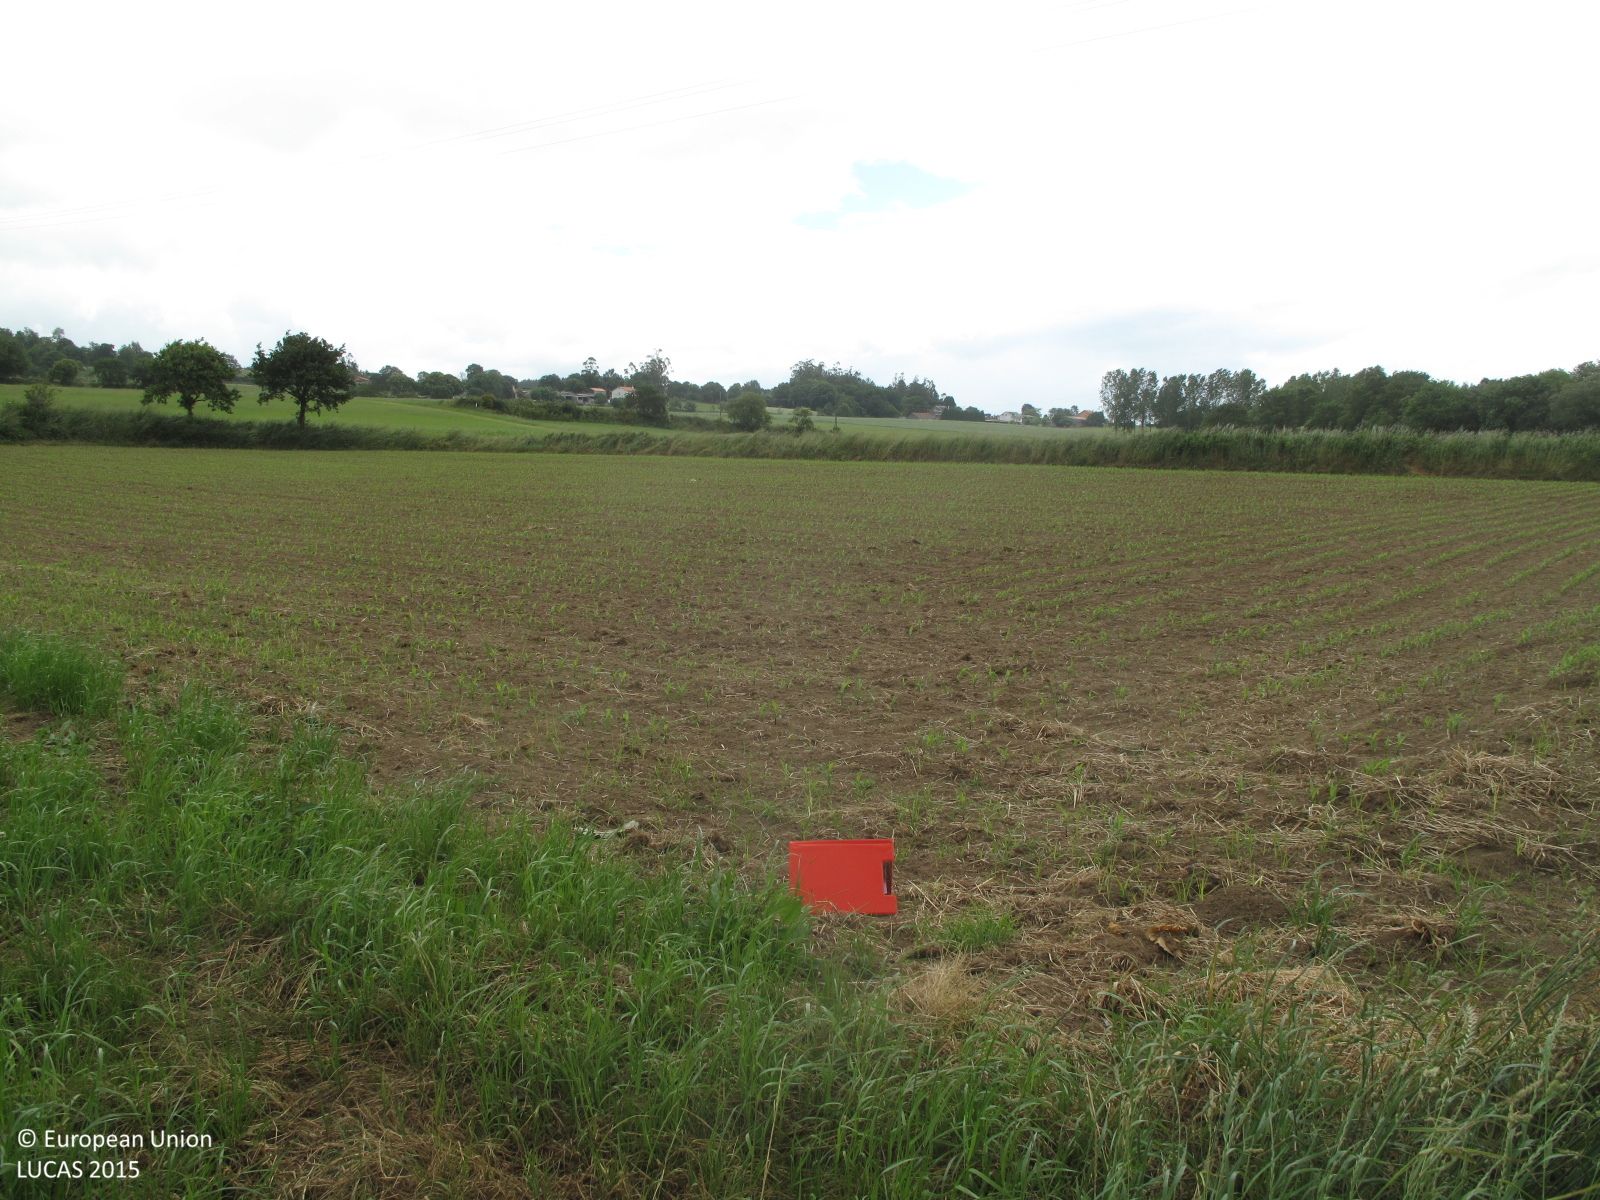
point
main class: Cropland
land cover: Maize
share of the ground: < 10 %
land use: Agriculture (excluding fallow land and kitchen gardens)
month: June
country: ES
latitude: 43.0725
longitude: -8.5160
